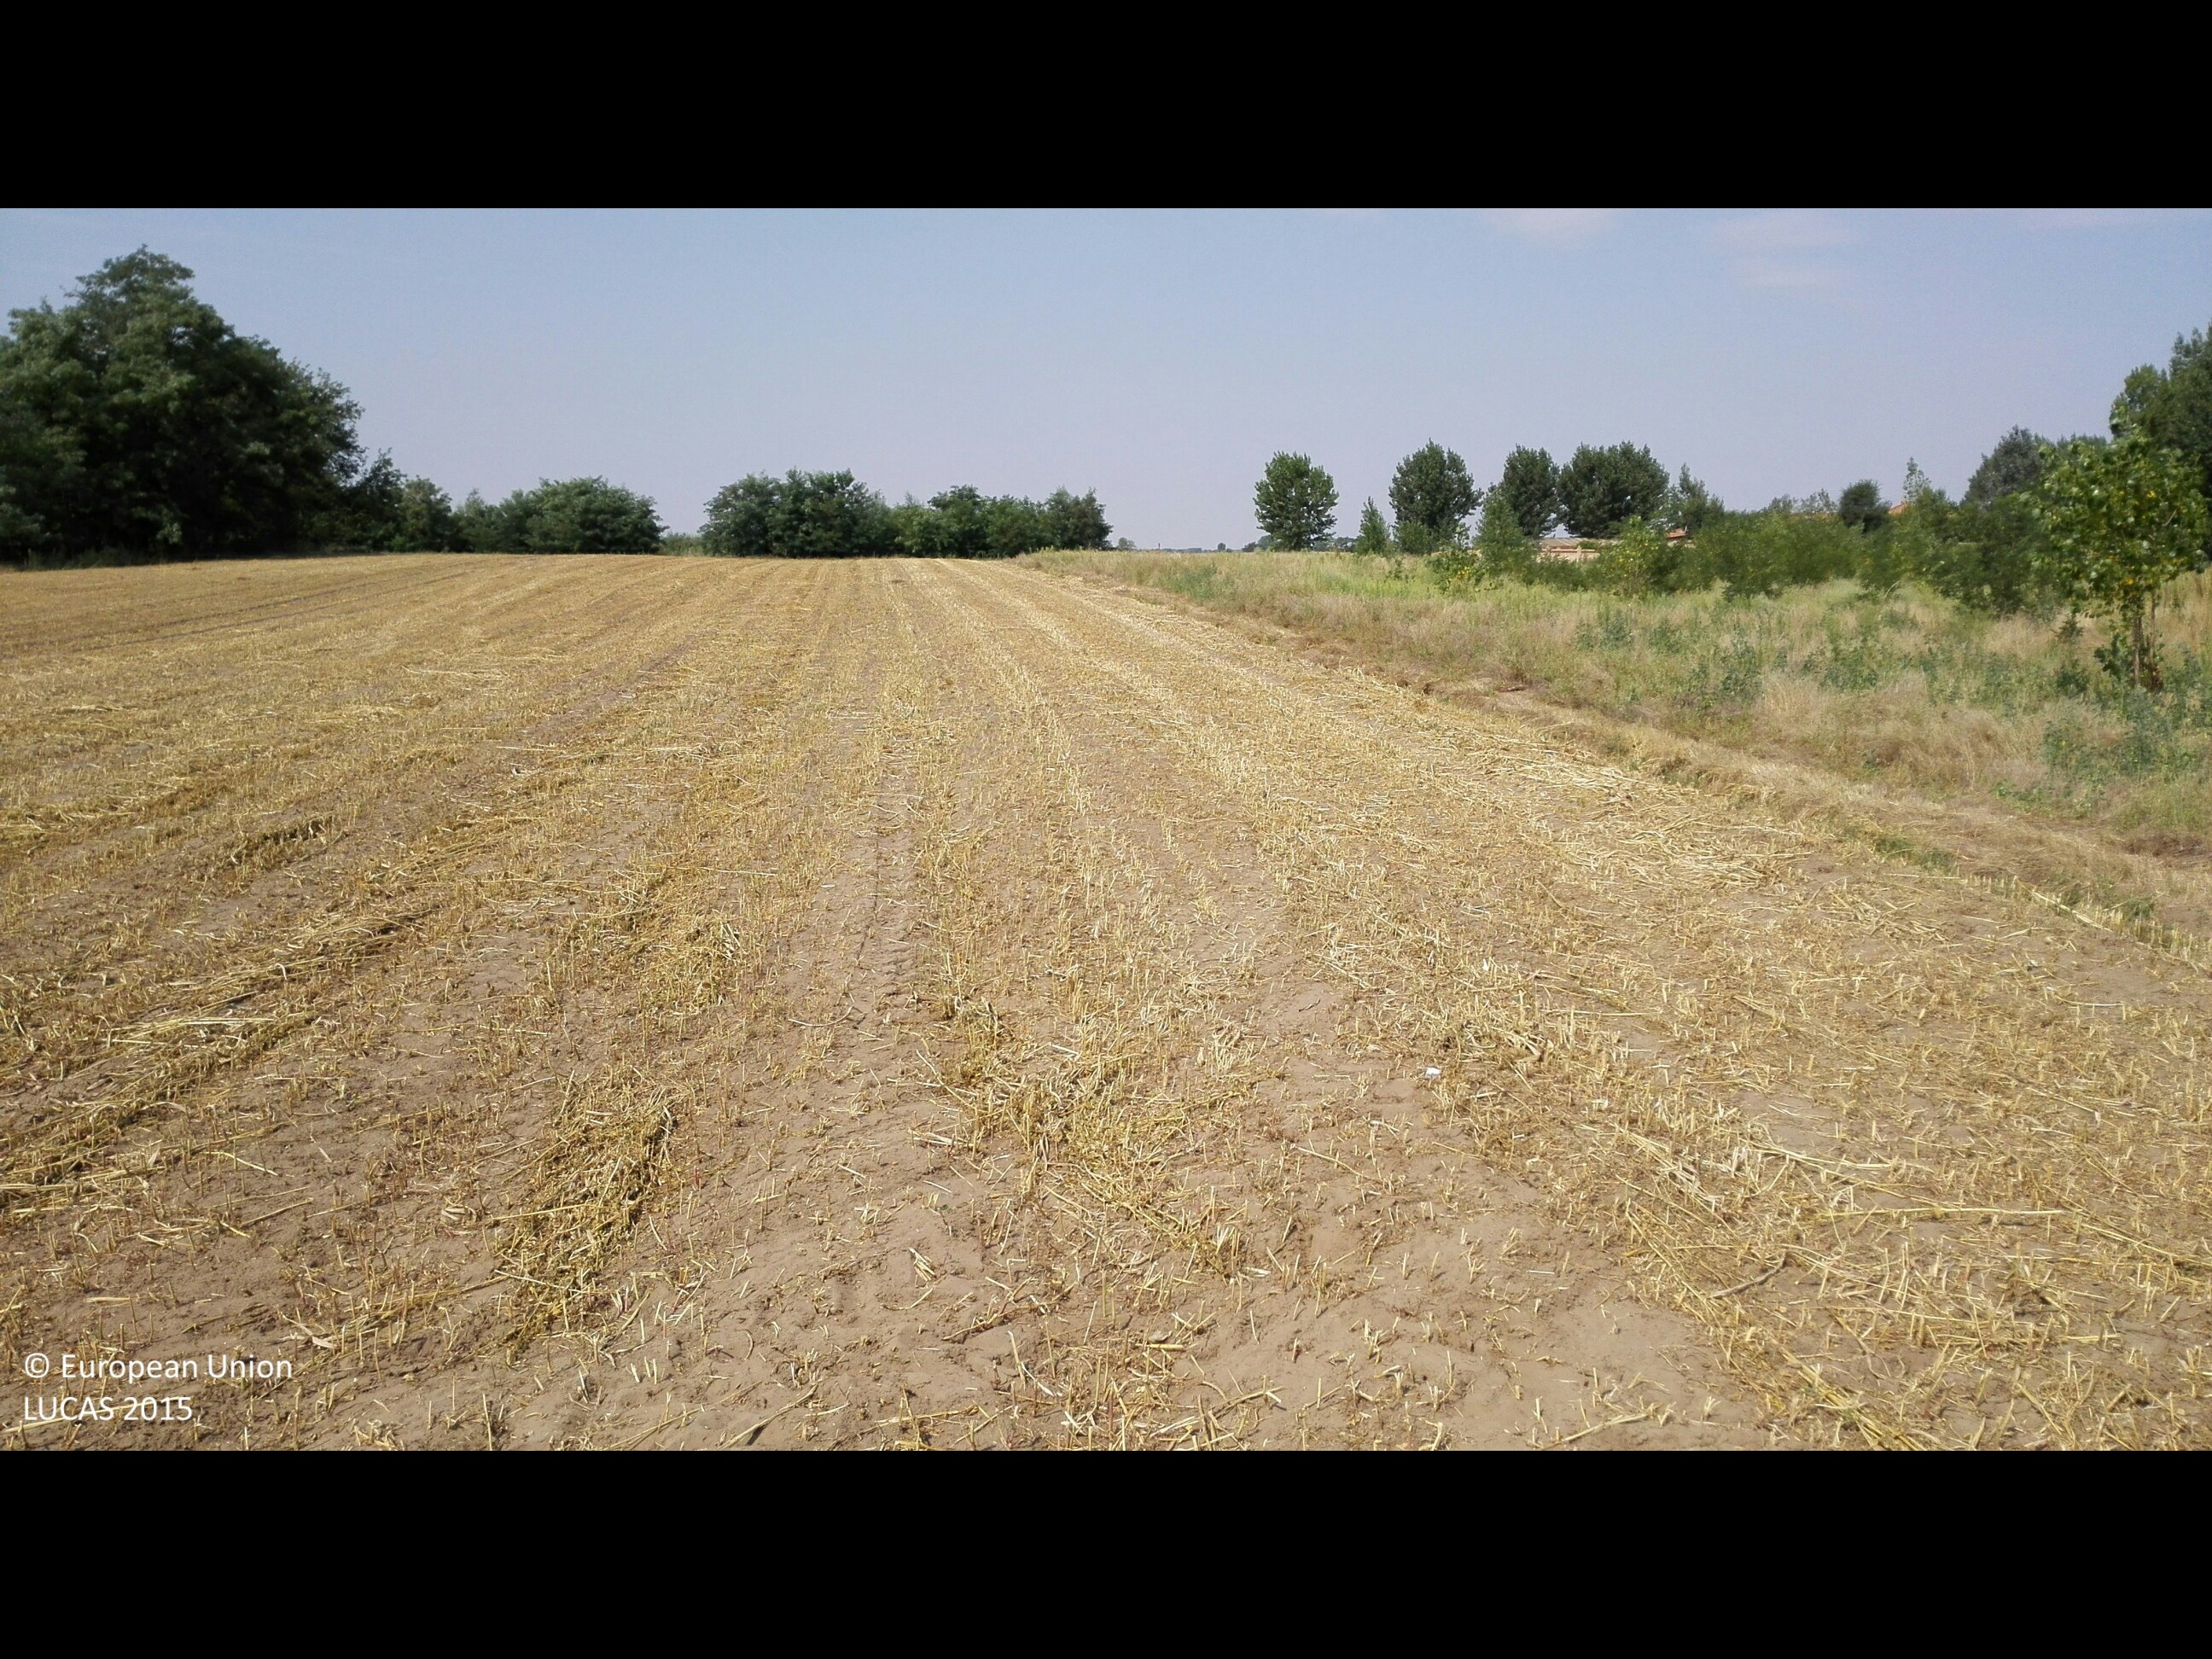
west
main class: Cropland
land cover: Rape and turnip rape
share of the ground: 10 - 25 %
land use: Agriculture (excluding fallow land and kitchen gardens)
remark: Harvested field
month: August
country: HU
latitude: 47.4757
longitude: 21.6552
